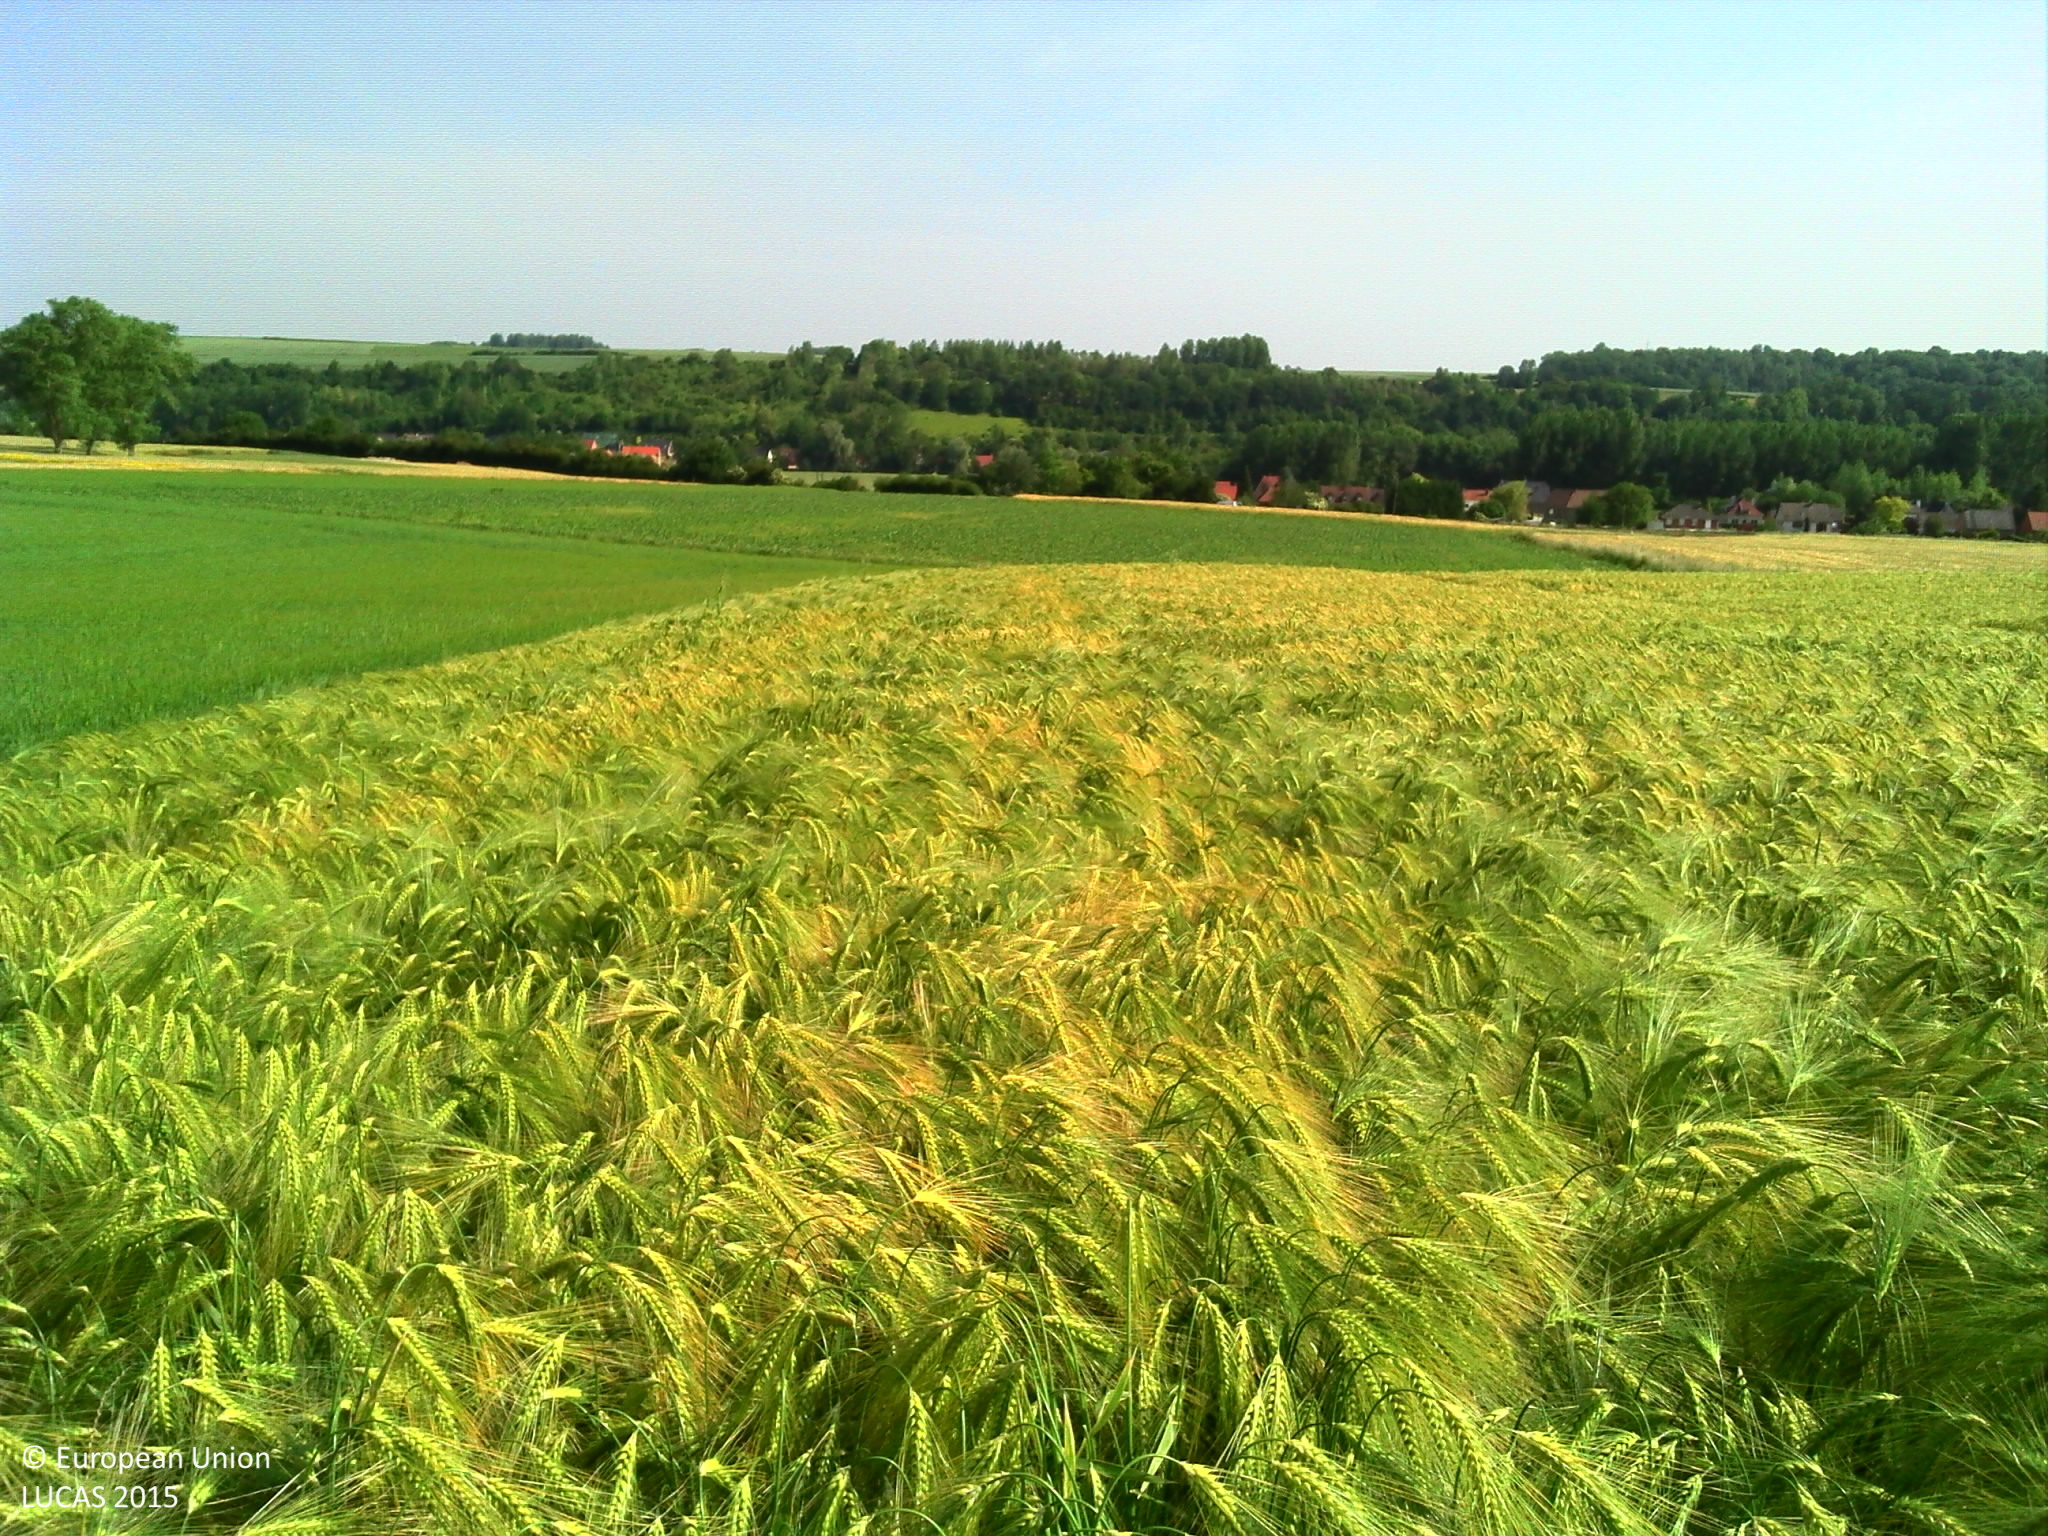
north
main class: Cropland
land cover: Barley
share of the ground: > 75 %
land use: Agriculture (excluding fallow land and kitchen gardens)
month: June
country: FR
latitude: 50.4755
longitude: 2.4484
